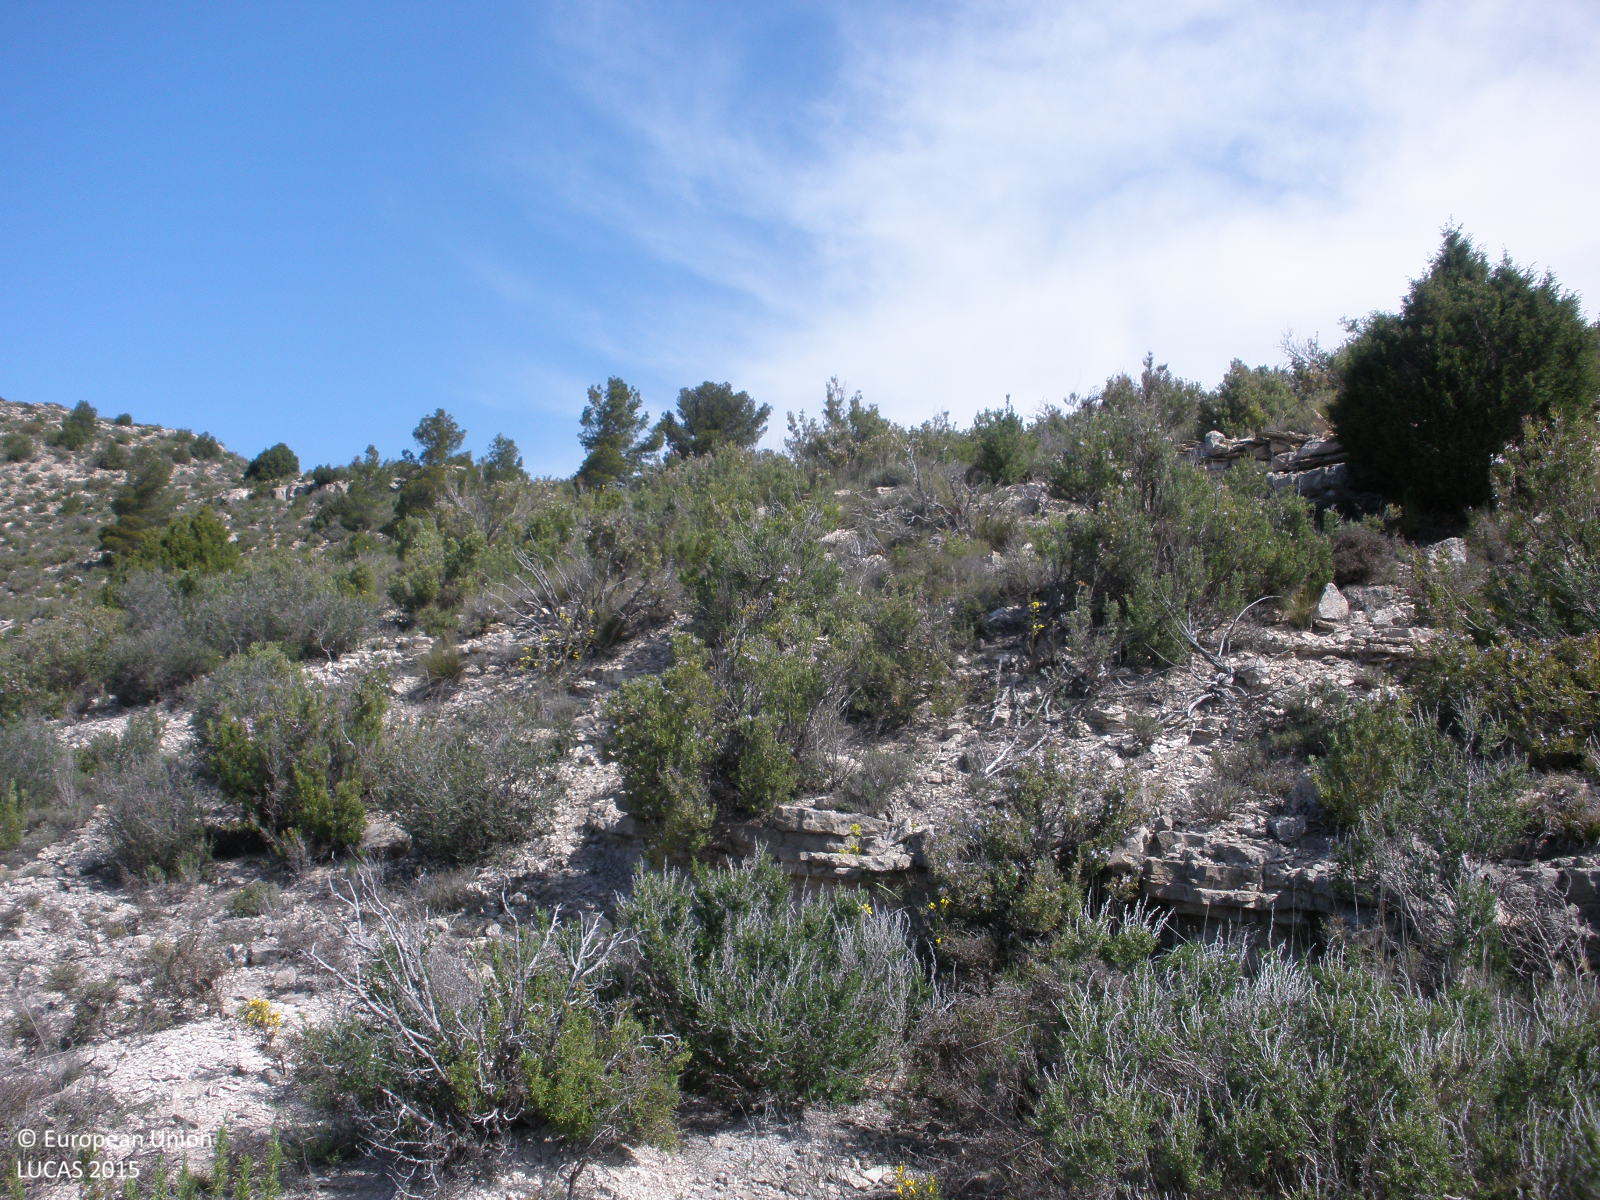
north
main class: Shrubland
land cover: Shrubland without tree cover
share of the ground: > 75 %
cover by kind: shrubs 80 %, consolidated bare surface 20 %
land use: Semi-natural and natural areas not in use
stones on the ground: 25 - 50 %
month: April
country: ES
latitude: 40.1534
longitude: -1.1971
